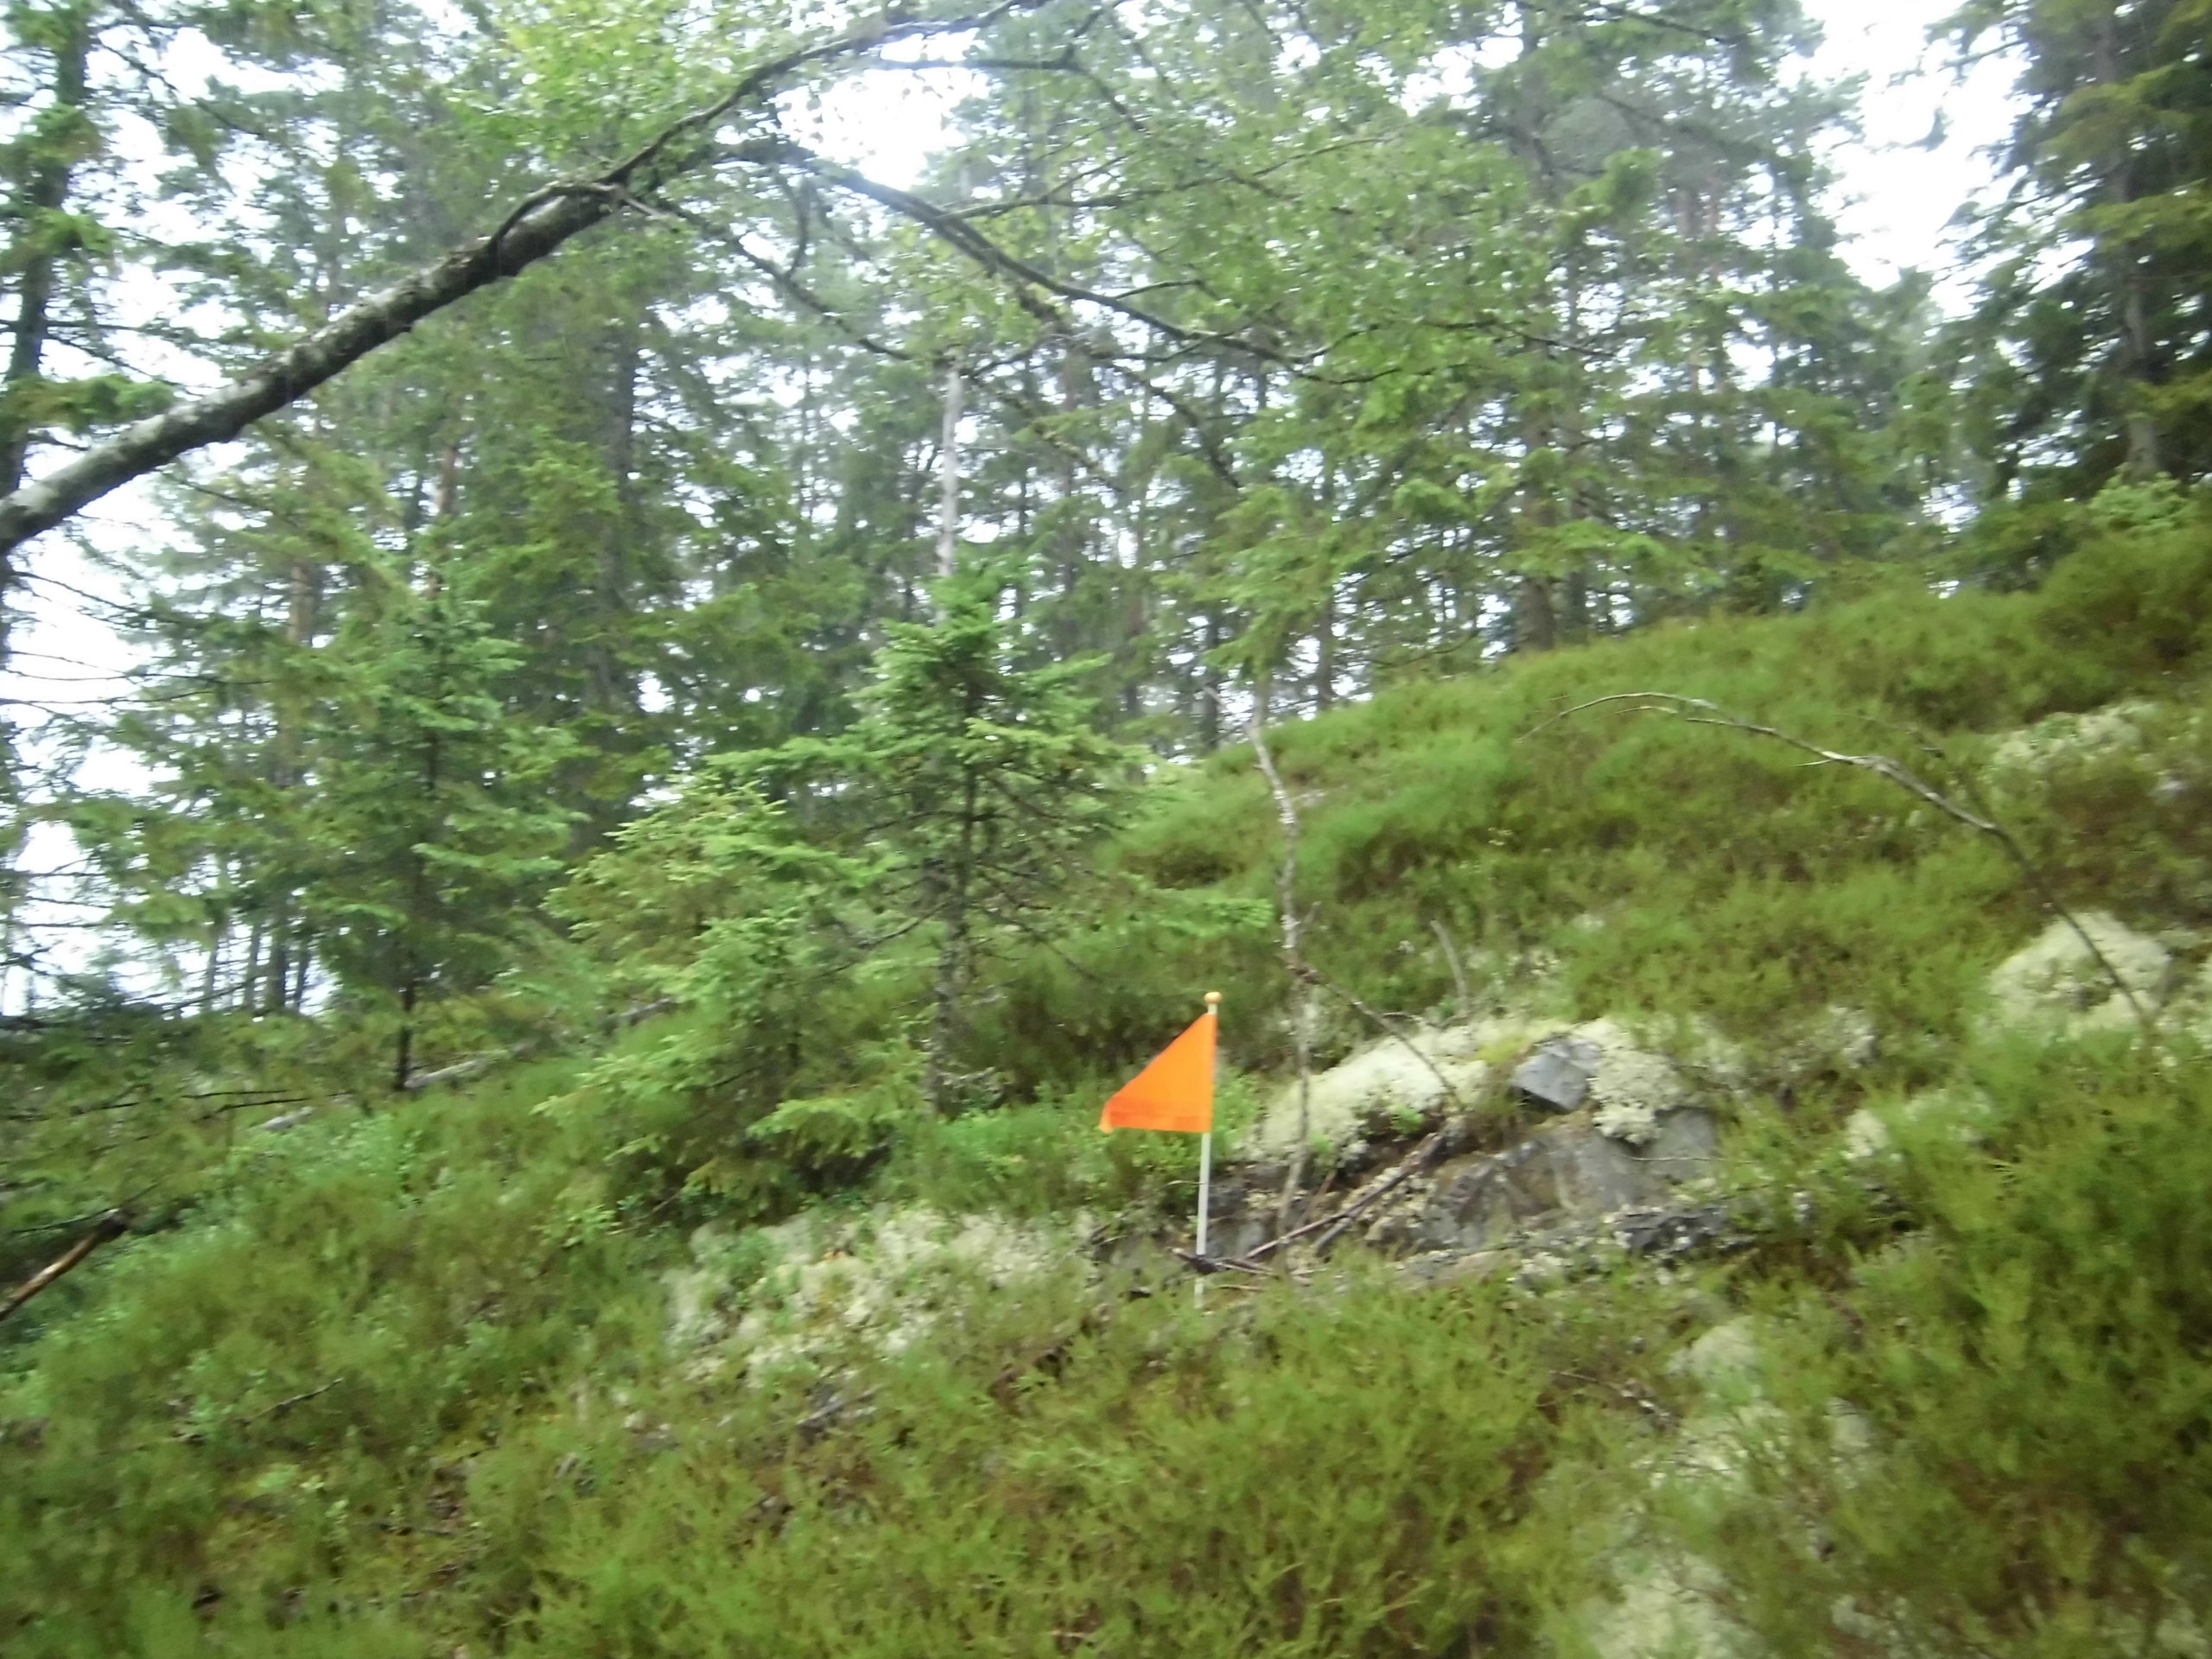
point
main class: Woodland
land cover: Spruce dominated coniferous woodland
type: boreal forest
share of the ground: 50 - 75 %
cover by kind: coniferous forest trees 45 %, shrubs 25 %, lichens and mosses 15 %, herbaceous plants 10 %, broadleaved forest trees 5 %
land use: Forestry
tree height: > 5 m
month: July
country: SE
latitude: 57.2211
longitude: 15.1142
